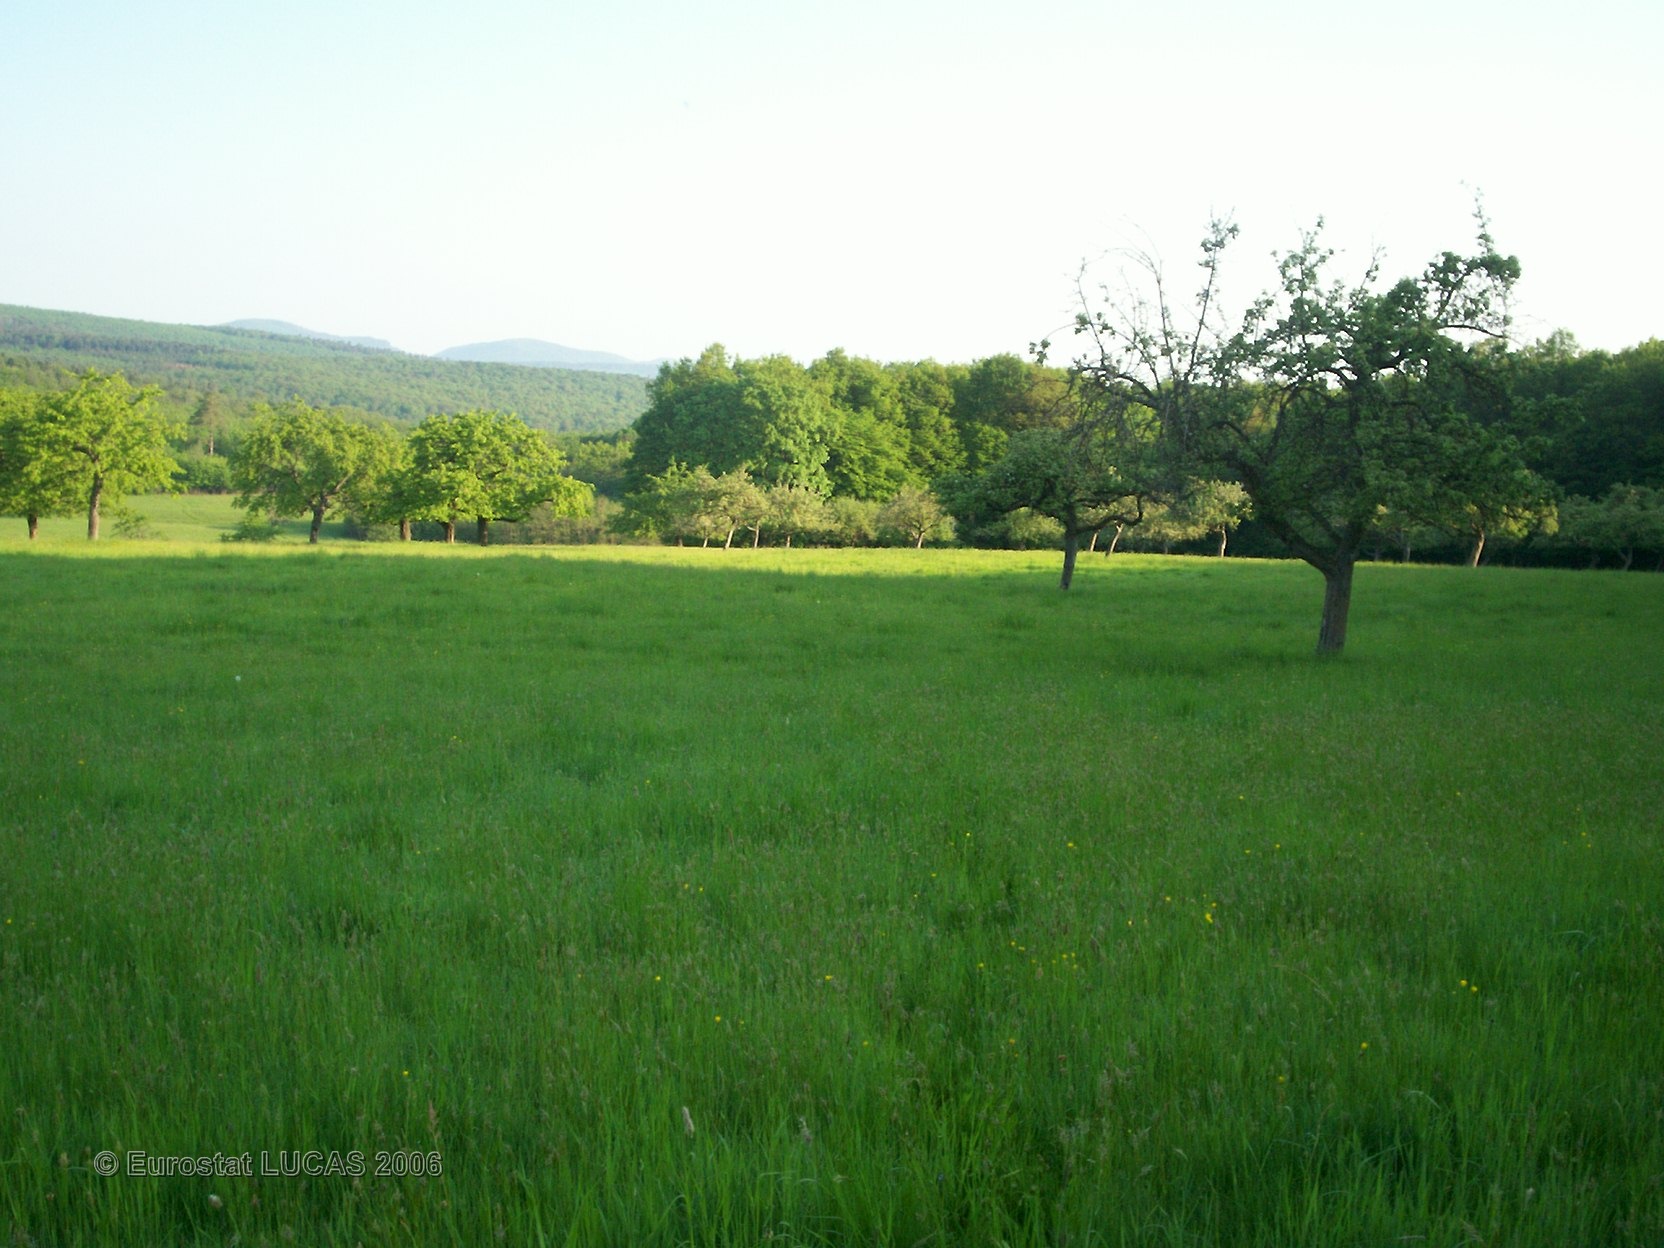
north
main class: Grassland
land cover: Grassland without tree/shrub cover
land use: Agriculture (excluding fallow land and kitchen gardens)
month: May
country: FR
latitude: 48.6245
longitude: 7.3823
